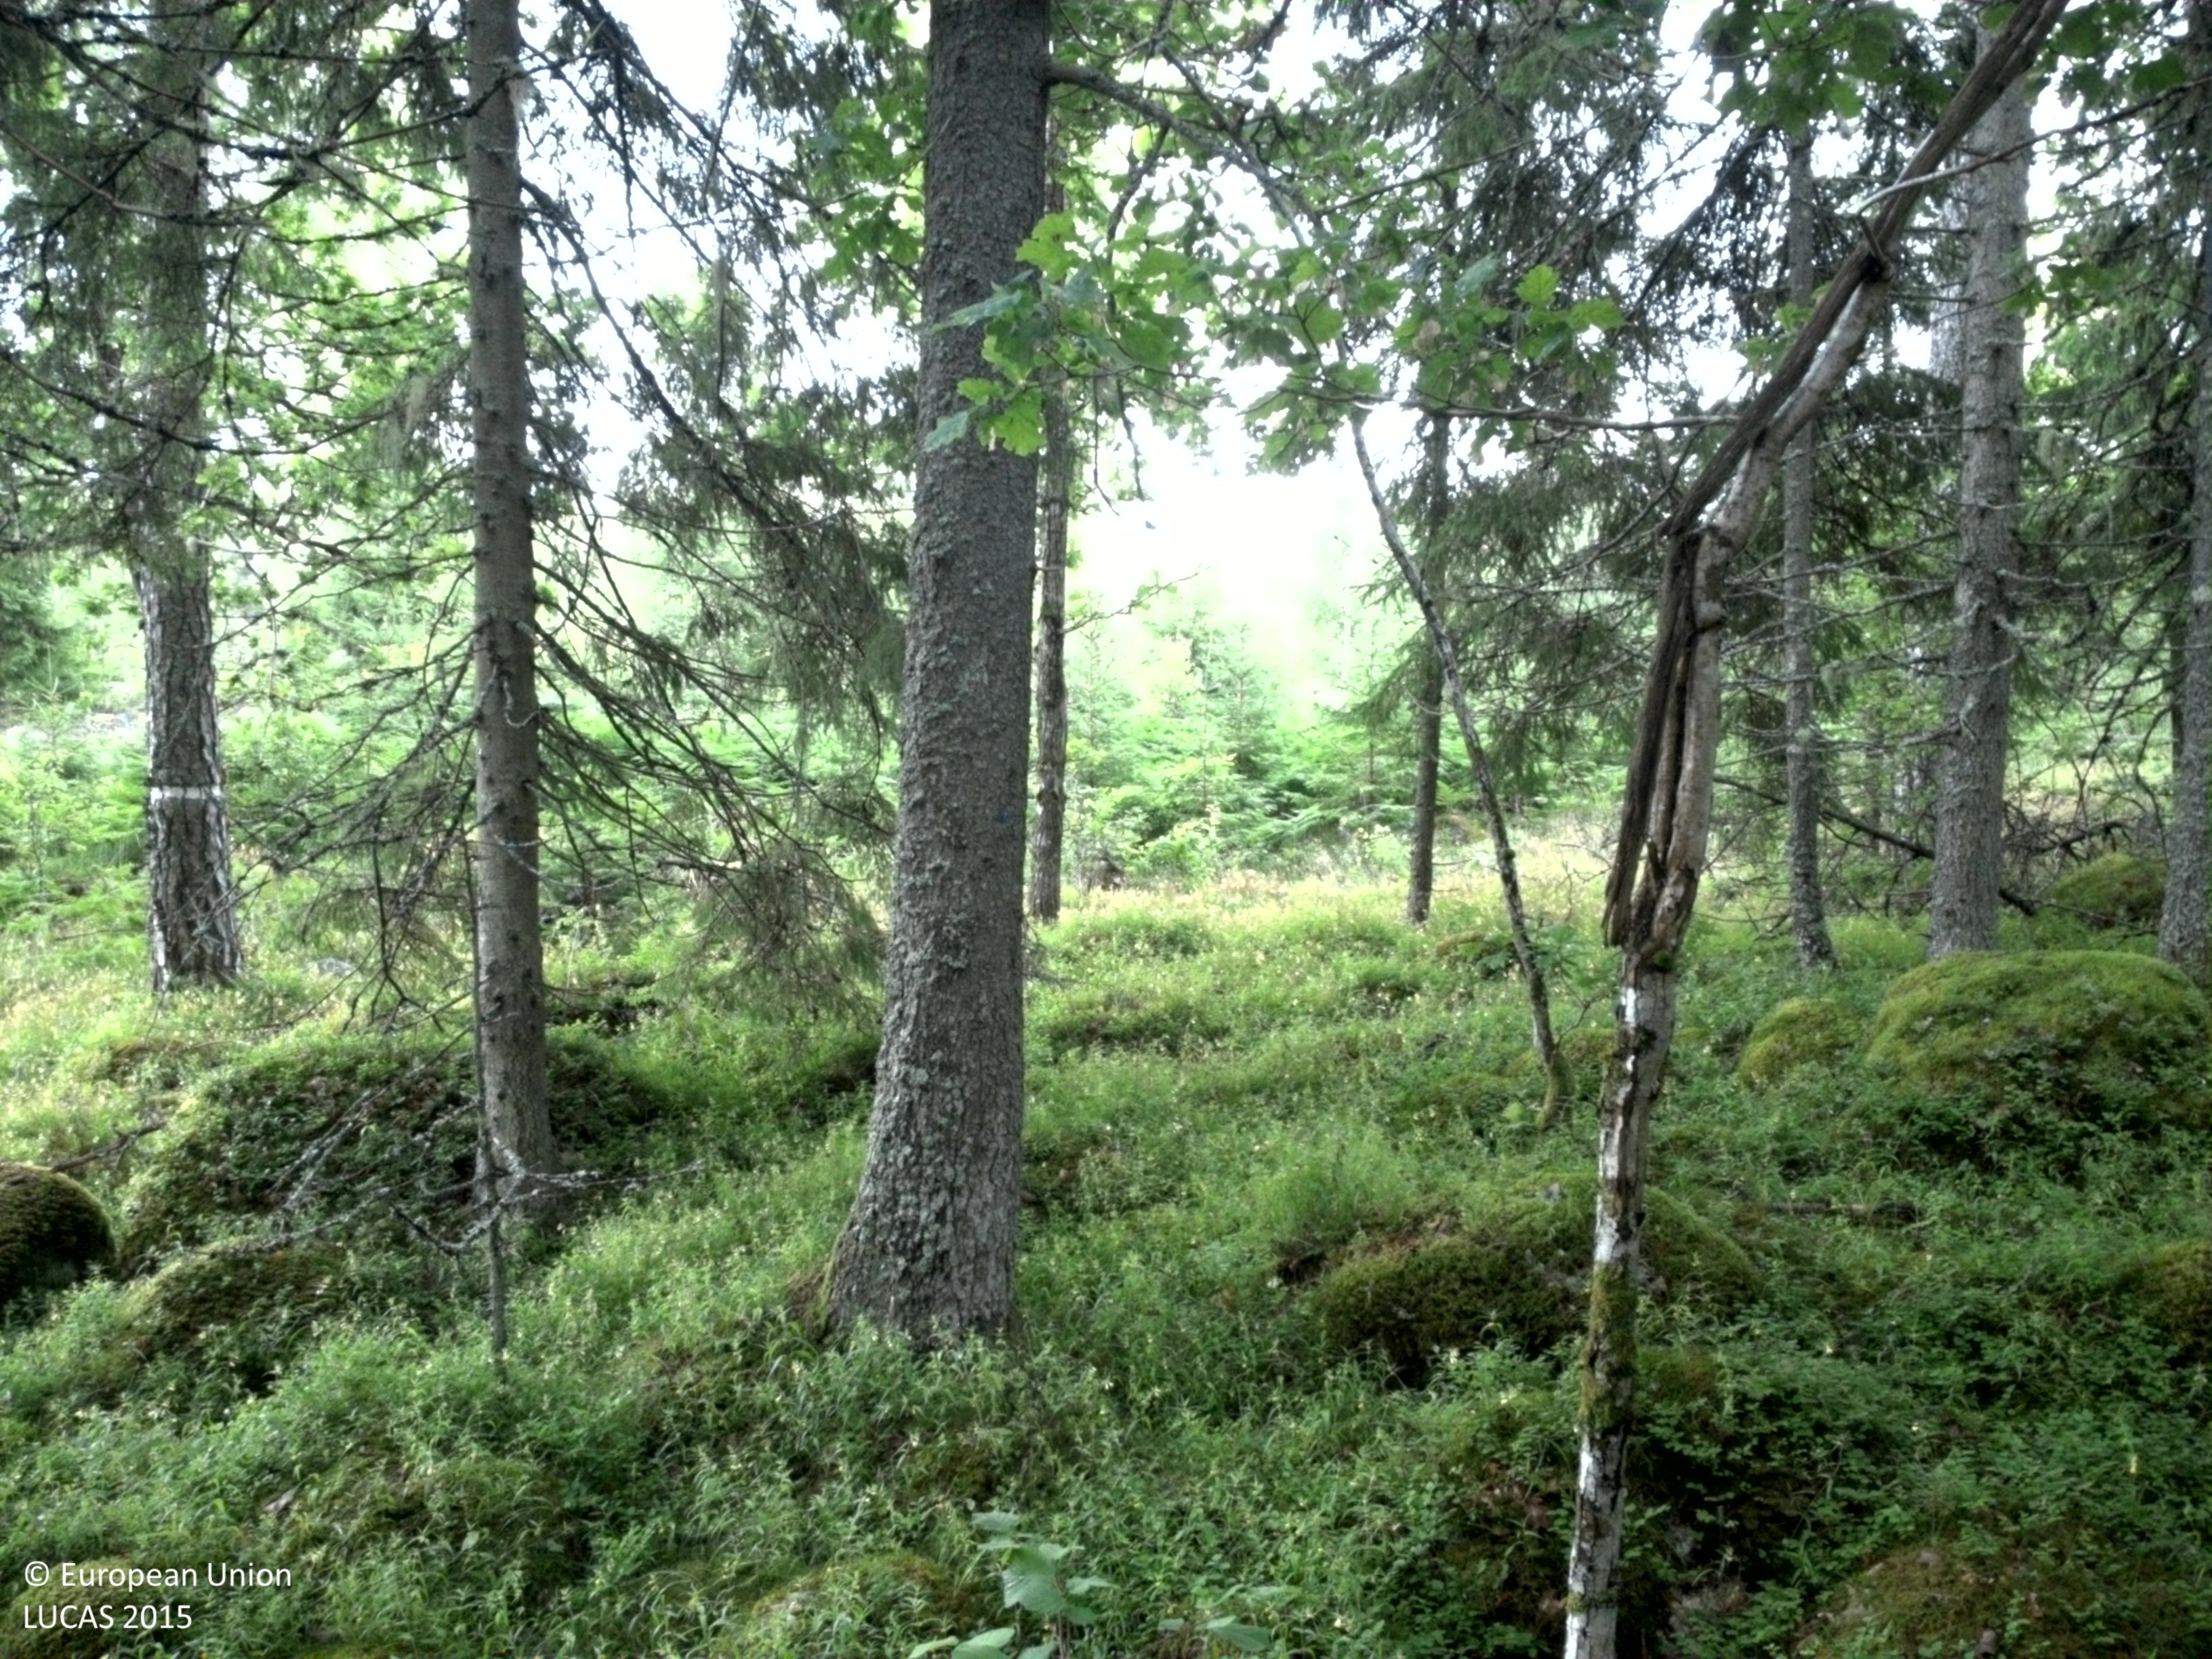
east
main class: Woodland
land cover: Spruce dominated coniferous woodland
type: boreal forest
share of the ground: 50 - 75 %
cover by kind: coniferous forest trees 55 %, shrubs 30 %, herbaceous plants 10 %, lichens and mosses 5 %
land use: Amenities, museums, leisure
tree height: > 5 m
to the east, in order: Spruce dominated coniferous woodland; Spruce dominated mixed woodland; Pine dominated mixed woodland; Spruce dominated mixed woodland; Ditches and canals; Spruce dominated mixed woodland
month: July
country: SE
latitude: 59.8798
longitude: 18.6279
